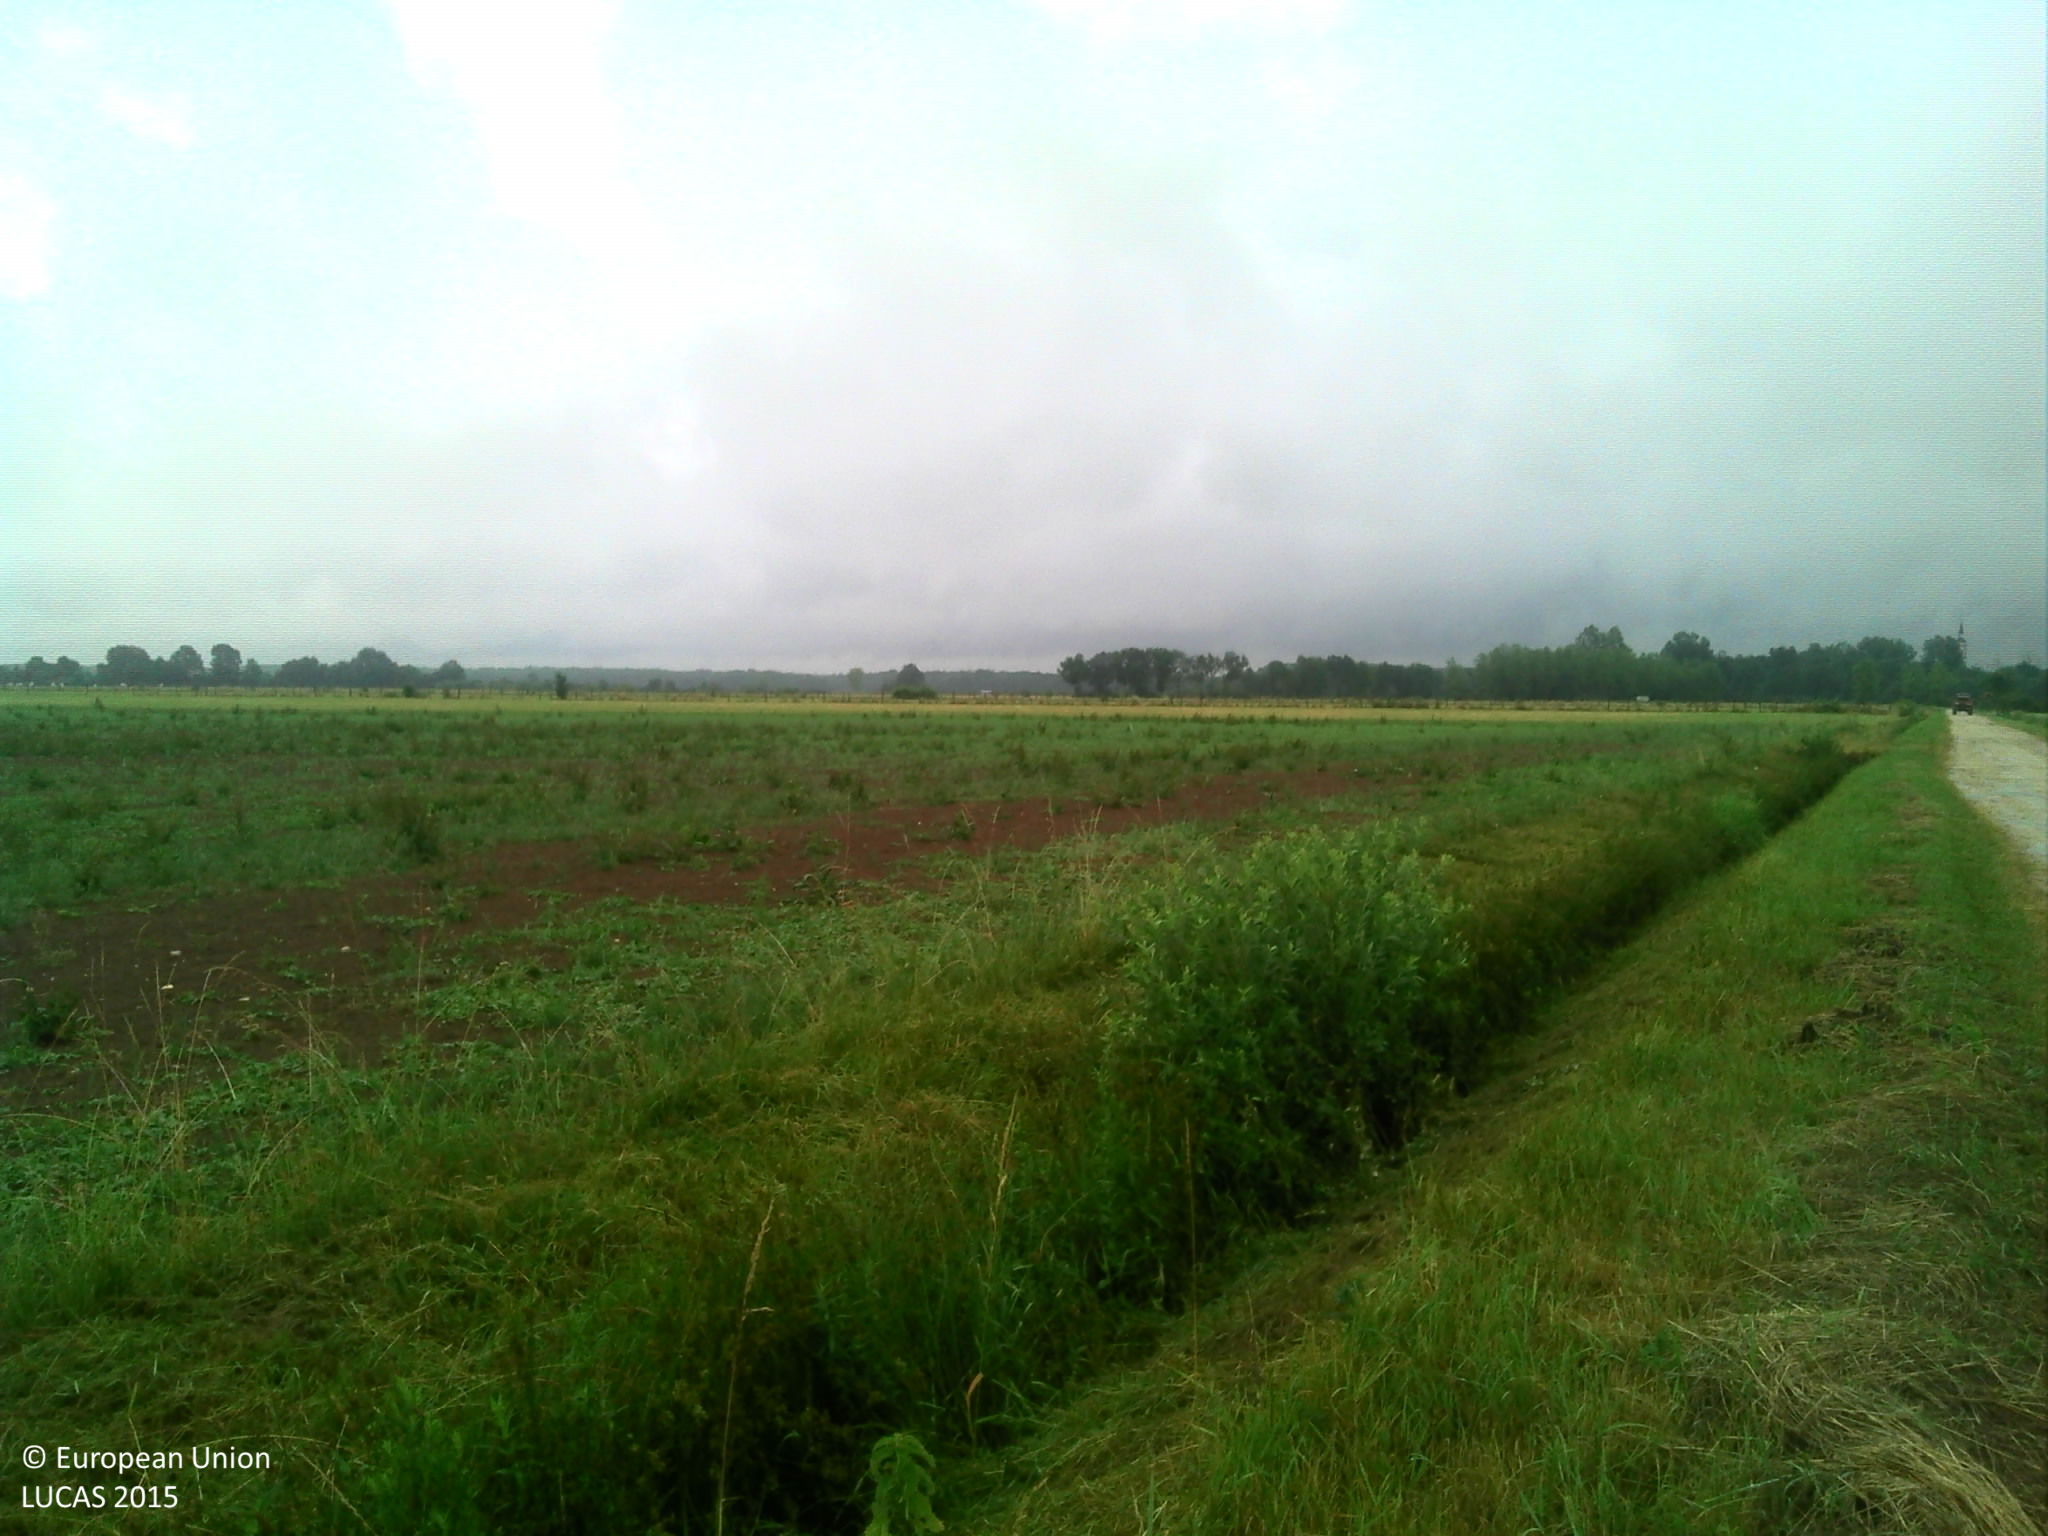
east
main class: Cropland
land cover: Dry pulses
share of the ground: > 75 %
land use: Agriculture (excluding fallow land and kitchen gardens)
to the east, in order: Grass margins; Ditches and canals; Dry pulses; Grassland without tree/shrub cover; Fences; Grassland without tree/shrub cover
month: June
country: FR
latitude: 47.3179
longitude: 5.4368
